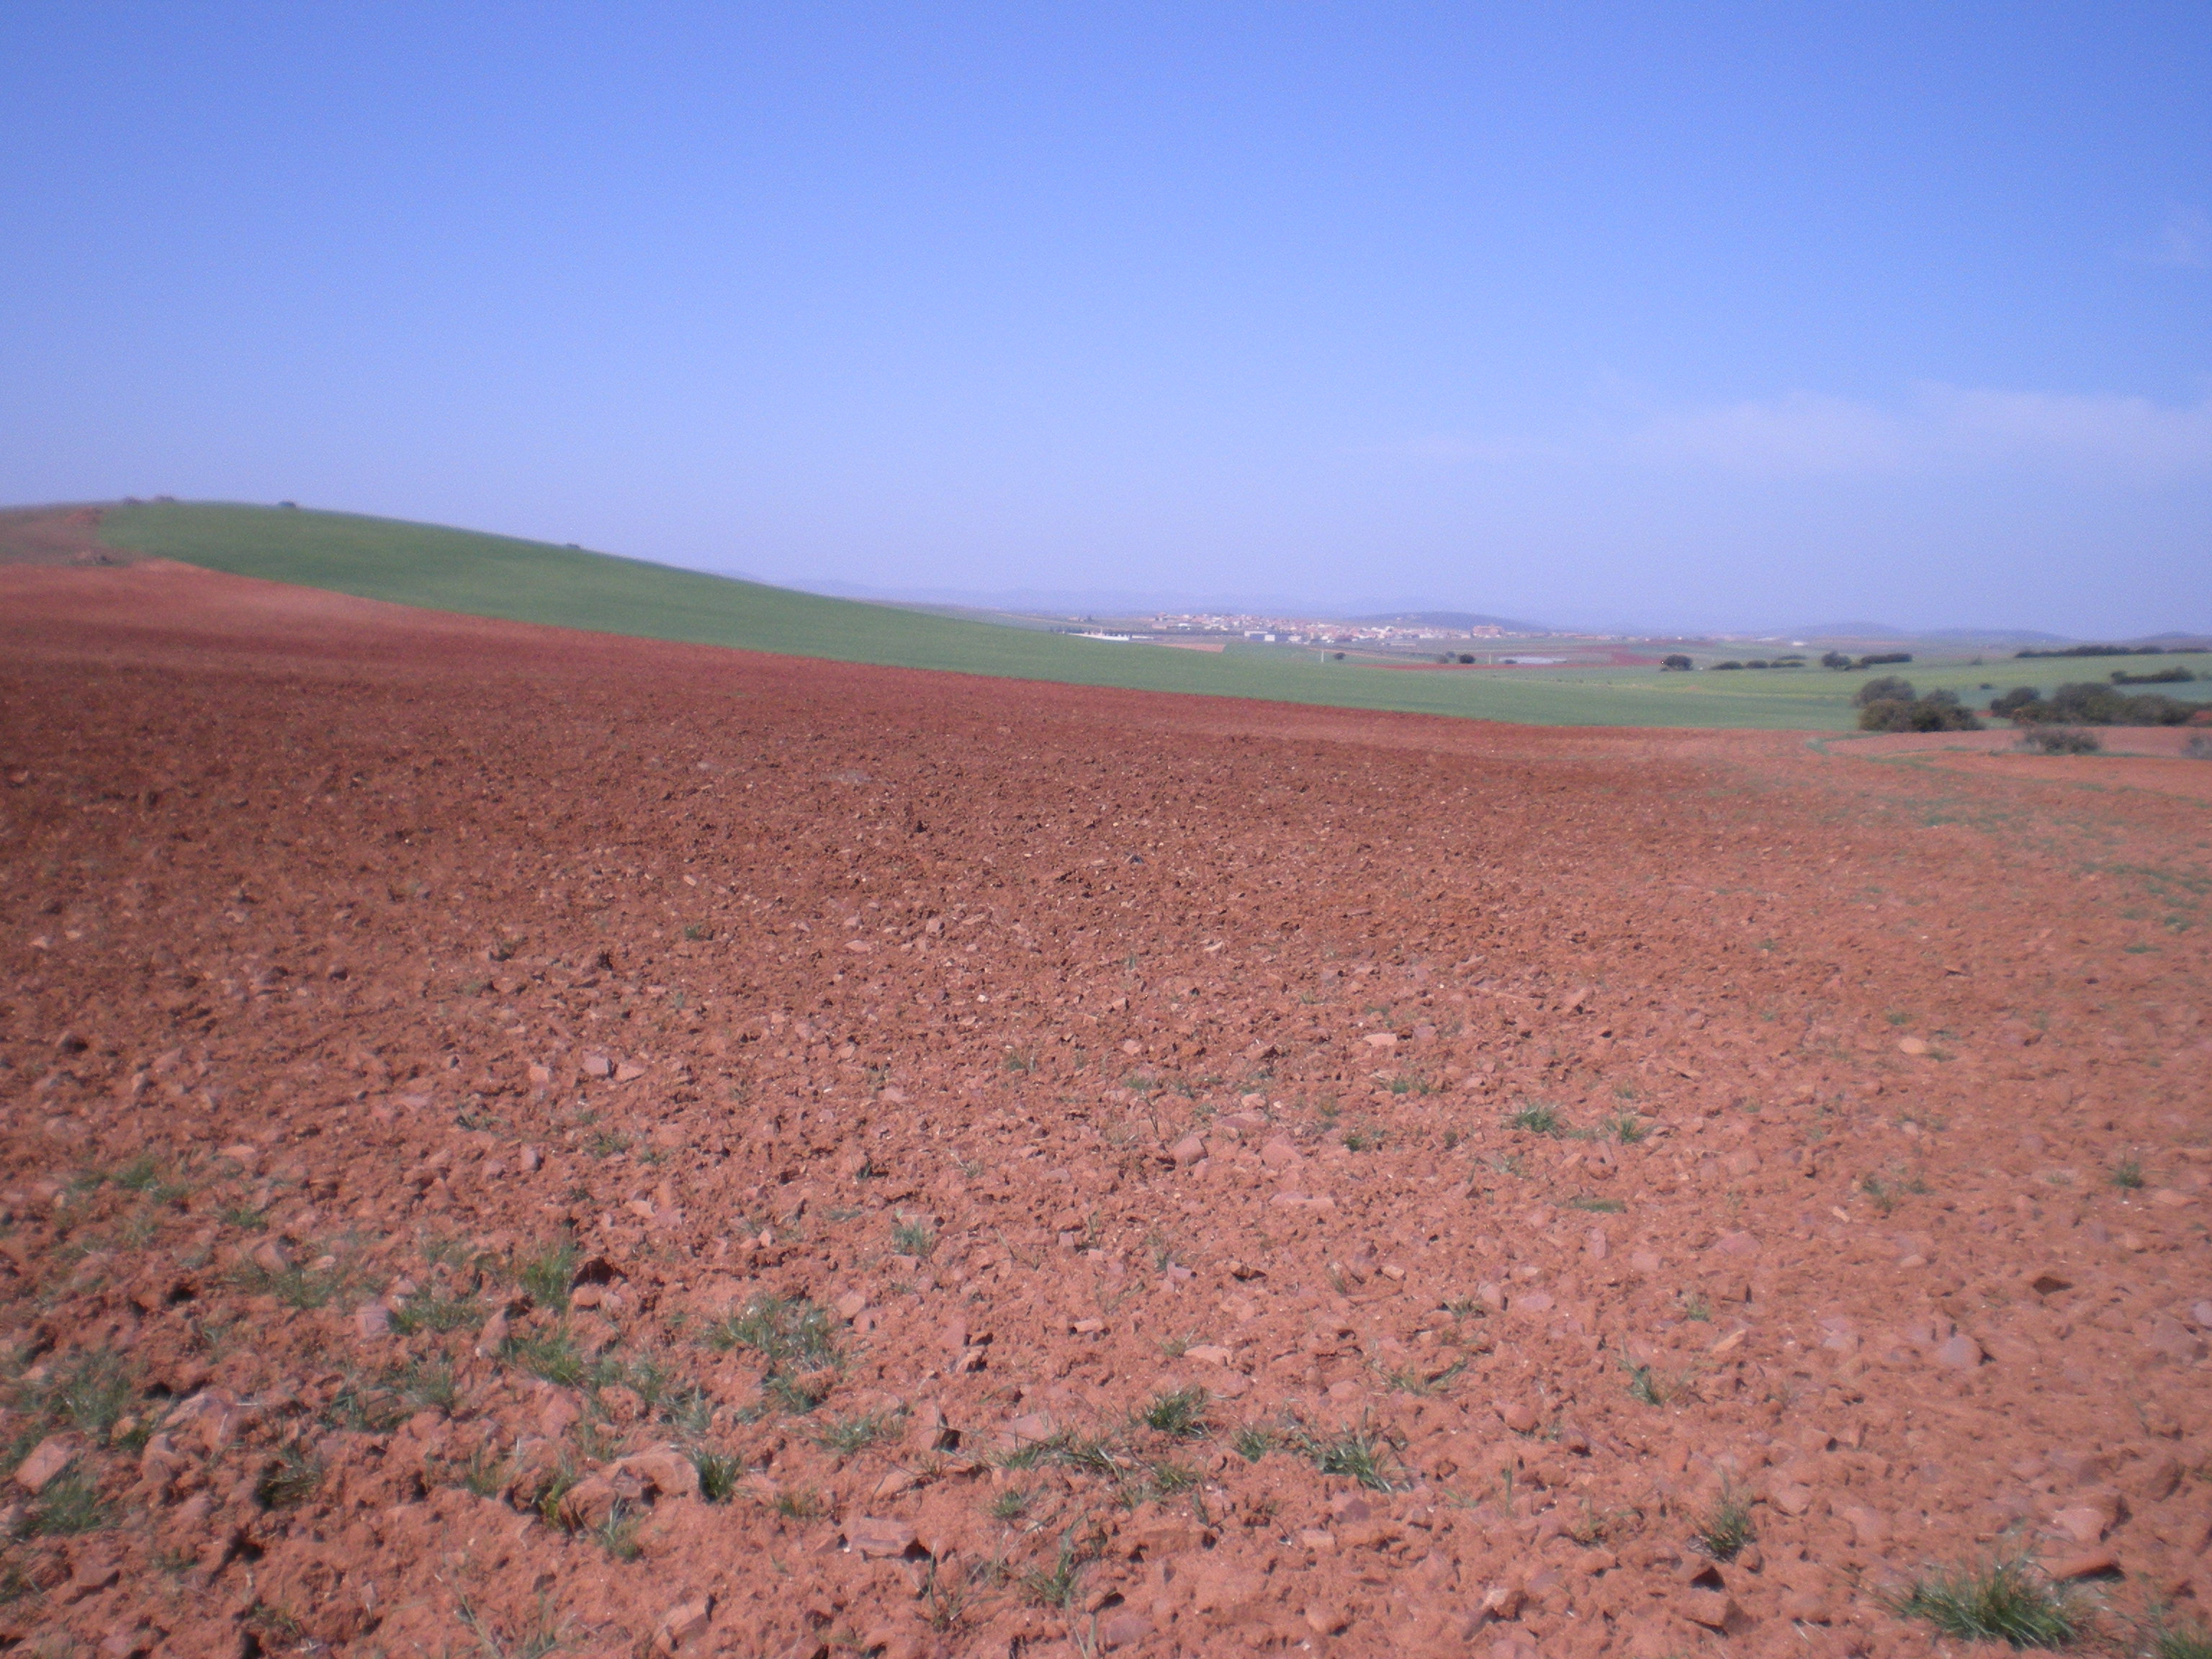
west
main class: Grassland
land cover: Spontaneously vegetated surfaces
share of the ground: 10 - 25 %
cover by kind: unconsolidated bare surface 80 %, herbaceous plants 20 %
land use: Fallow land
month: April
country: ES
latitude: 38.5219
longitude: -3.5089
